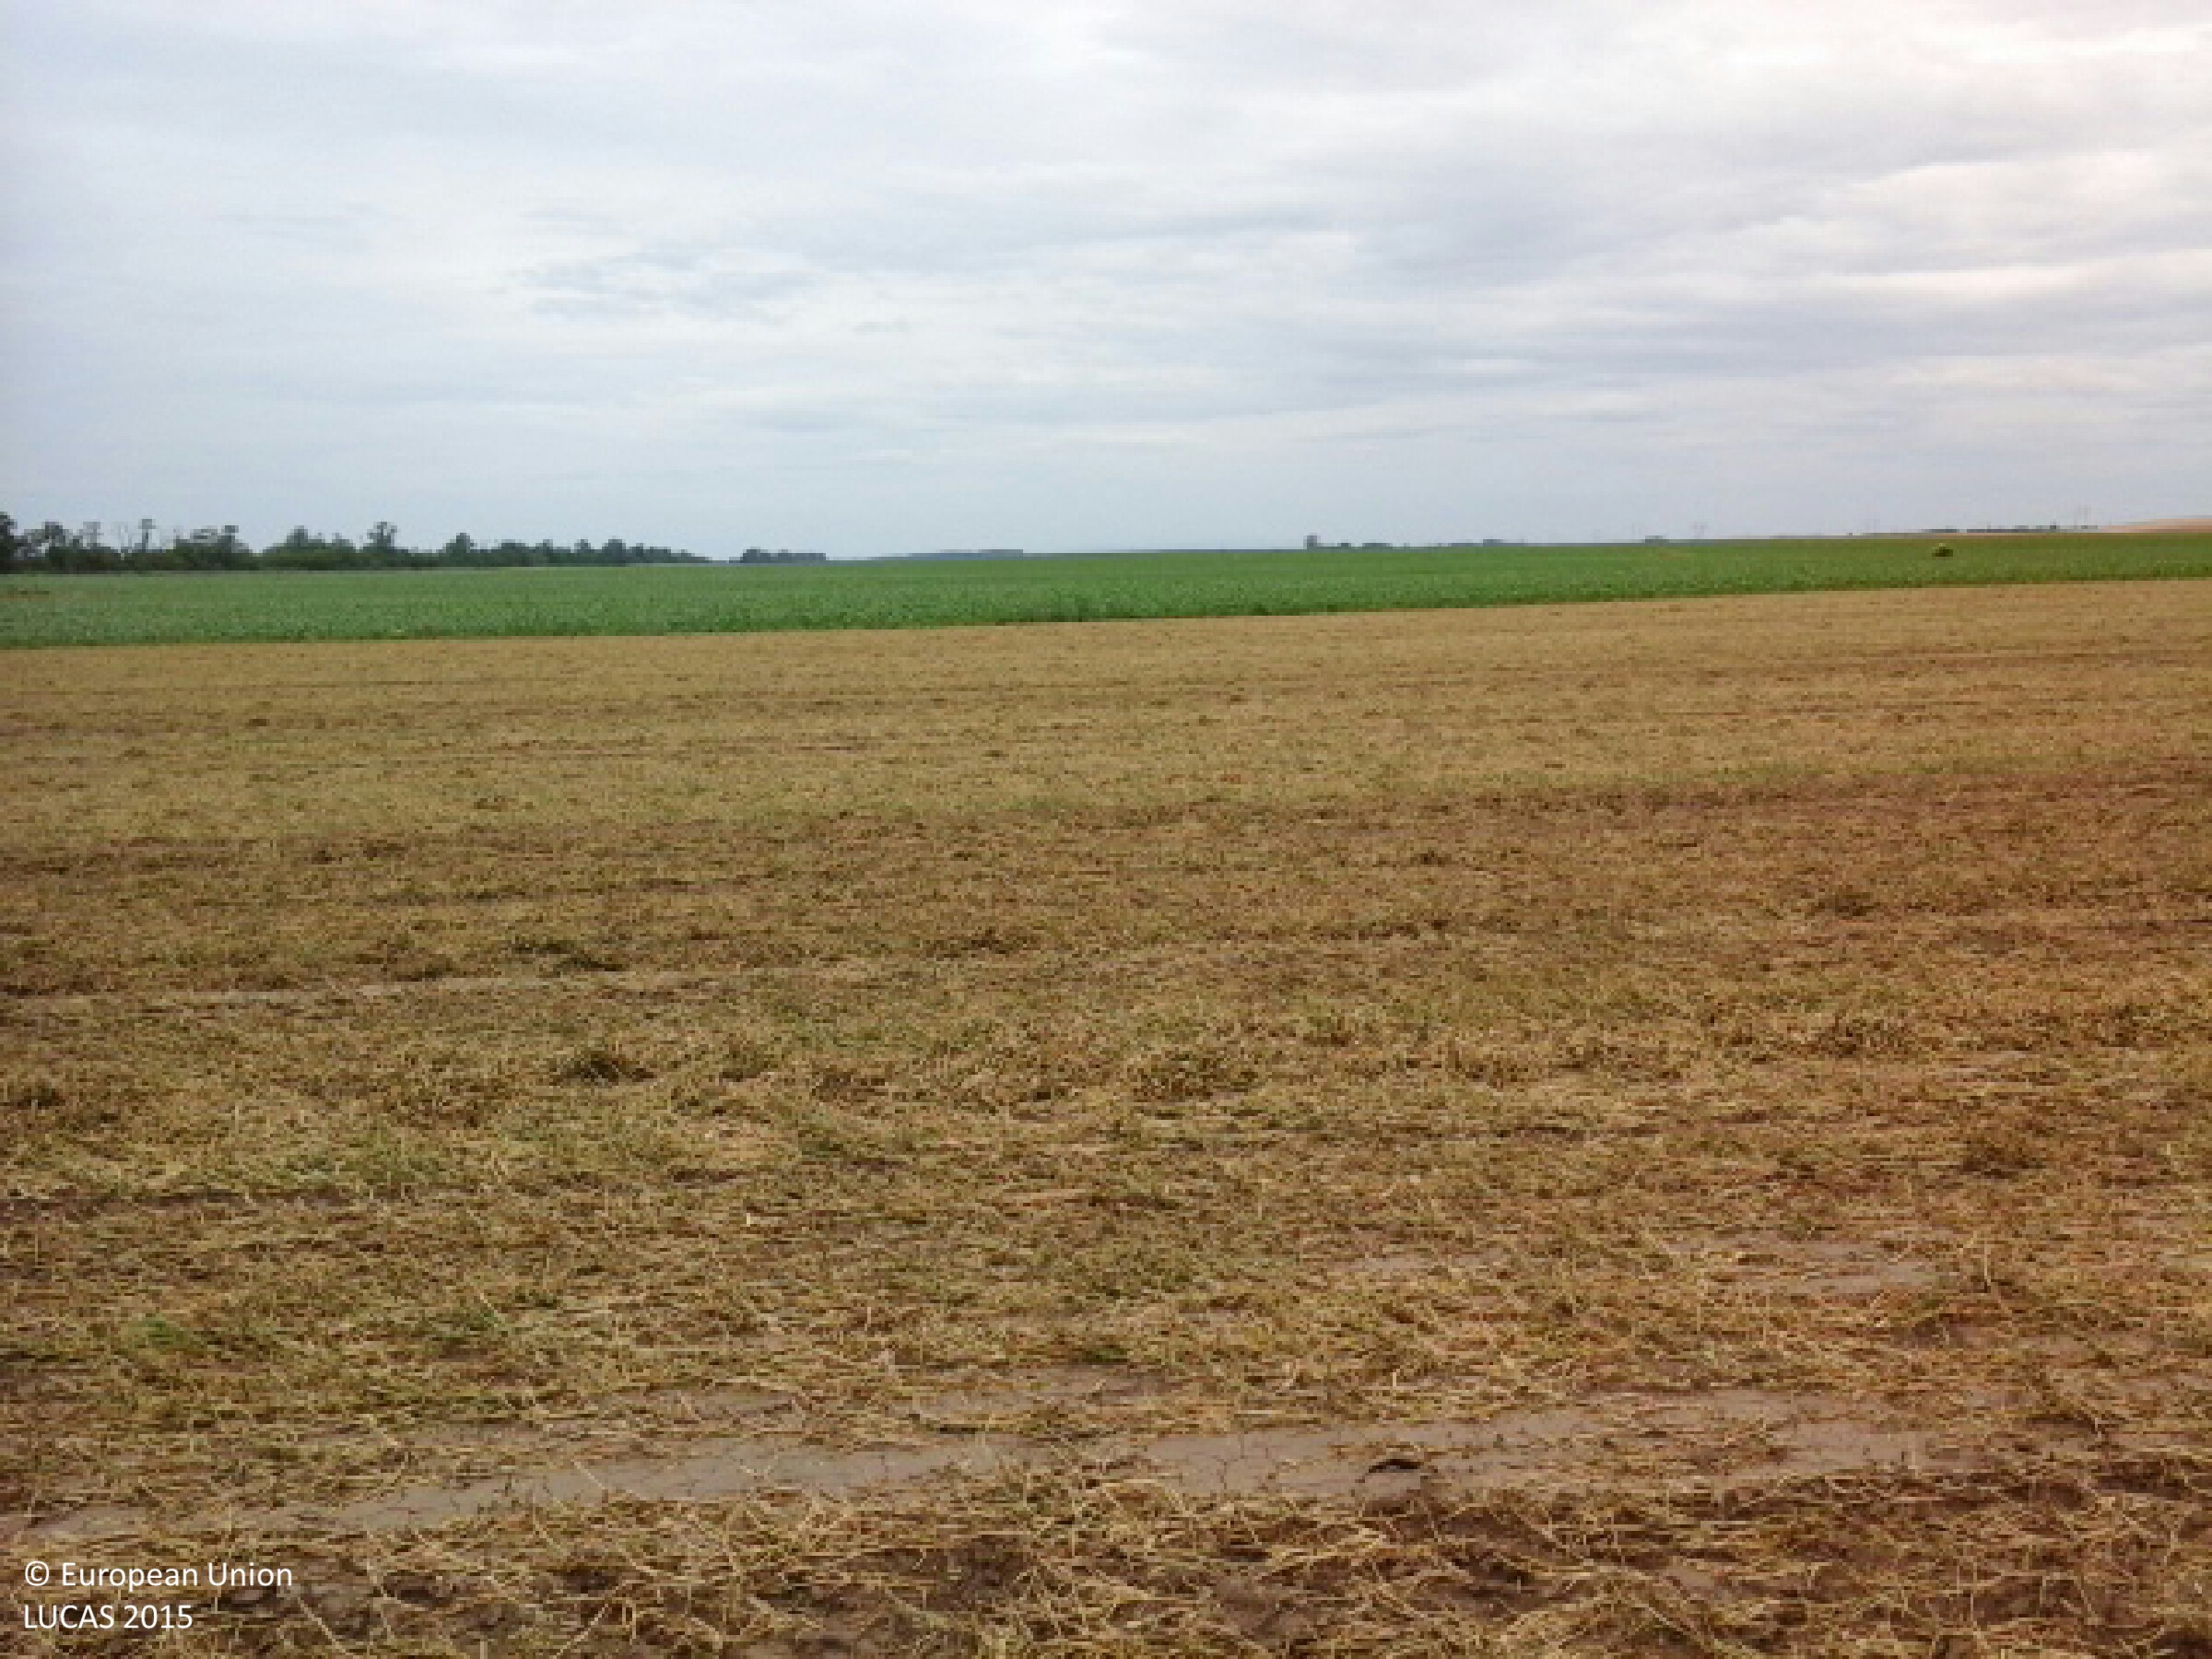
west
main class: Cropland
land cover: Dry pulses
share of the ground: < 10 %
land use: Agriculture (excluding fallow land and kitchen gardens)
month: June
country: HU
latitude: 47.9652
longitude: 21.4965
